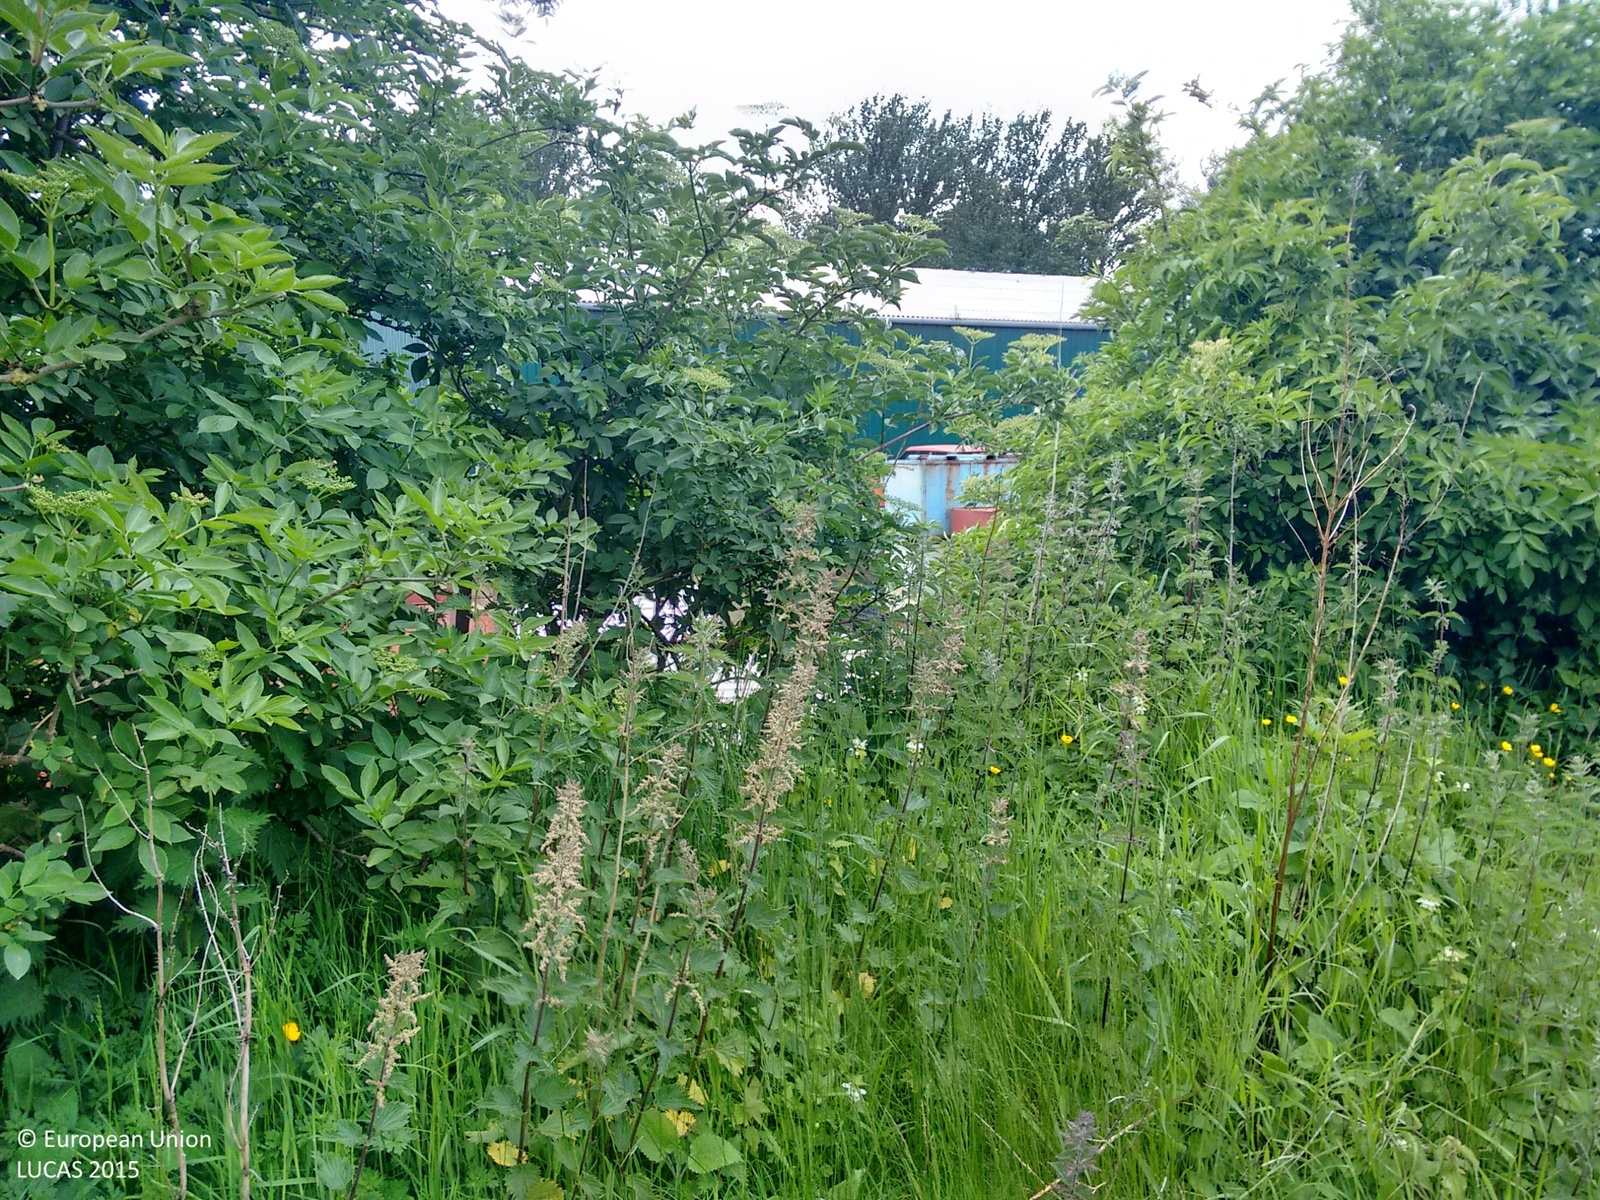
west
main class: Grassland
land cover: Spontaneously vegetated surfaces
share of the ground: > 75 %
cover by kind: herbaceous plants 100 %
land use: Agriculture (excluding fallow land and kitchen gardens)
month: June
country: GB
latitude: 53.4976
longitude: -0.1788
